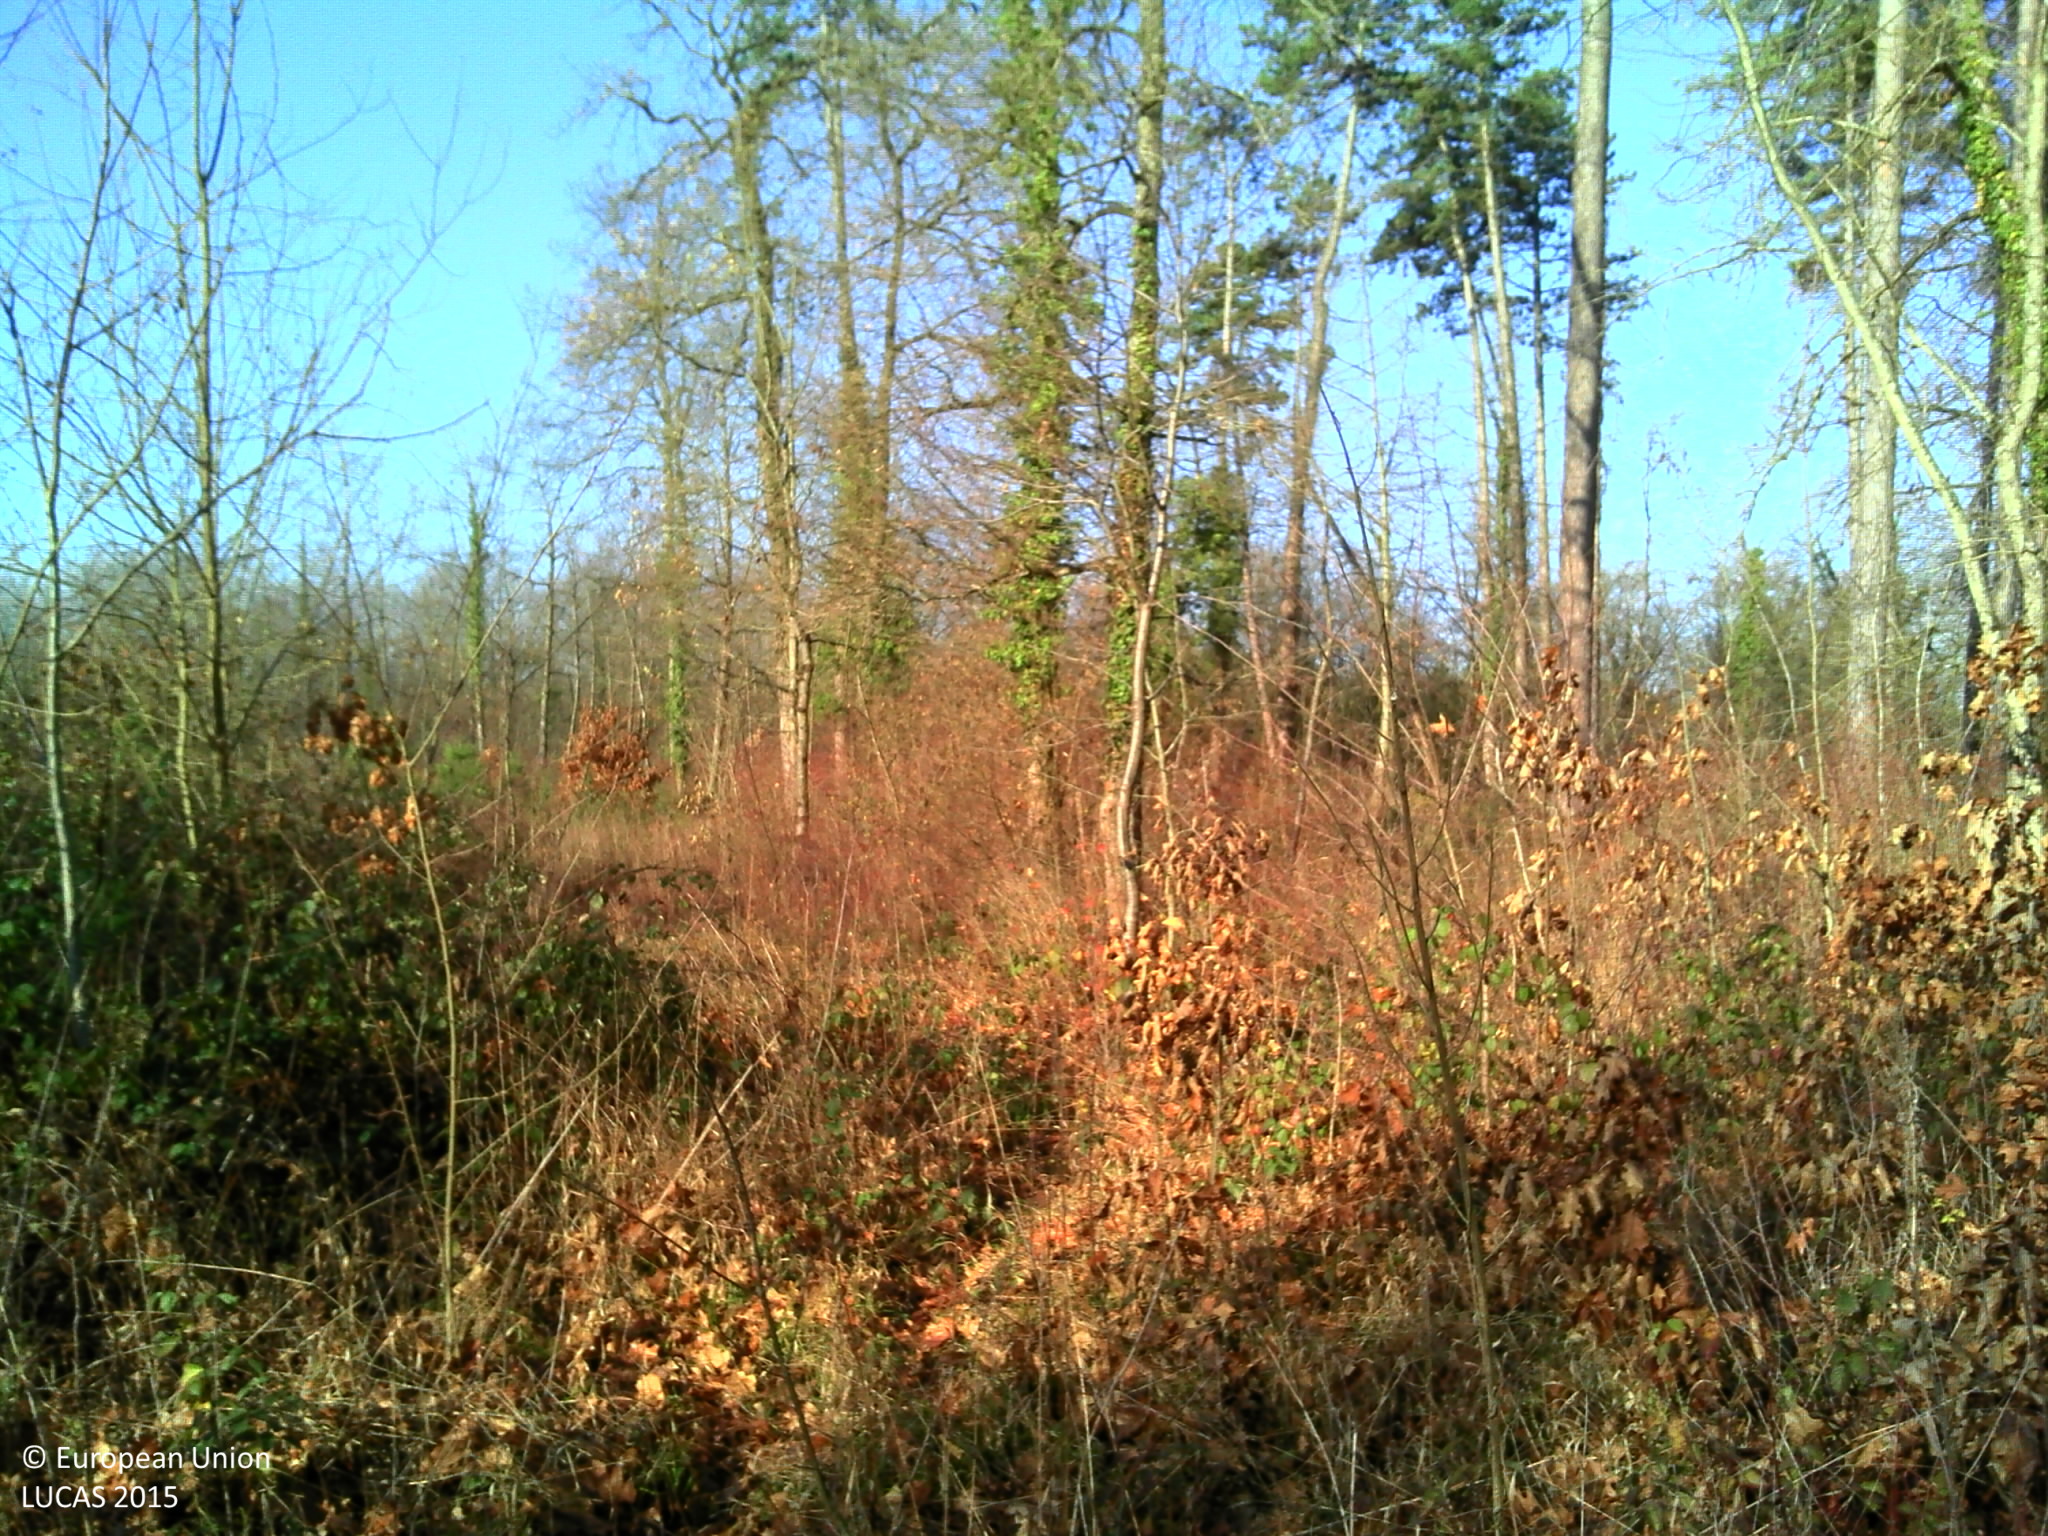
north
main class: Woodland
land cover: Pine dominated mixed woodland
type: mesophytic deciduous forest
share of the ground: > 75 %
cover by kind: coniferous forest trees 45 %, broadleaved forest trees 45 %, herbaceous plants 10 %
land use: Forestry
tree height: > 5 m
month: December
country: FR
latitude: 45.8691
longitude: 5.3018
